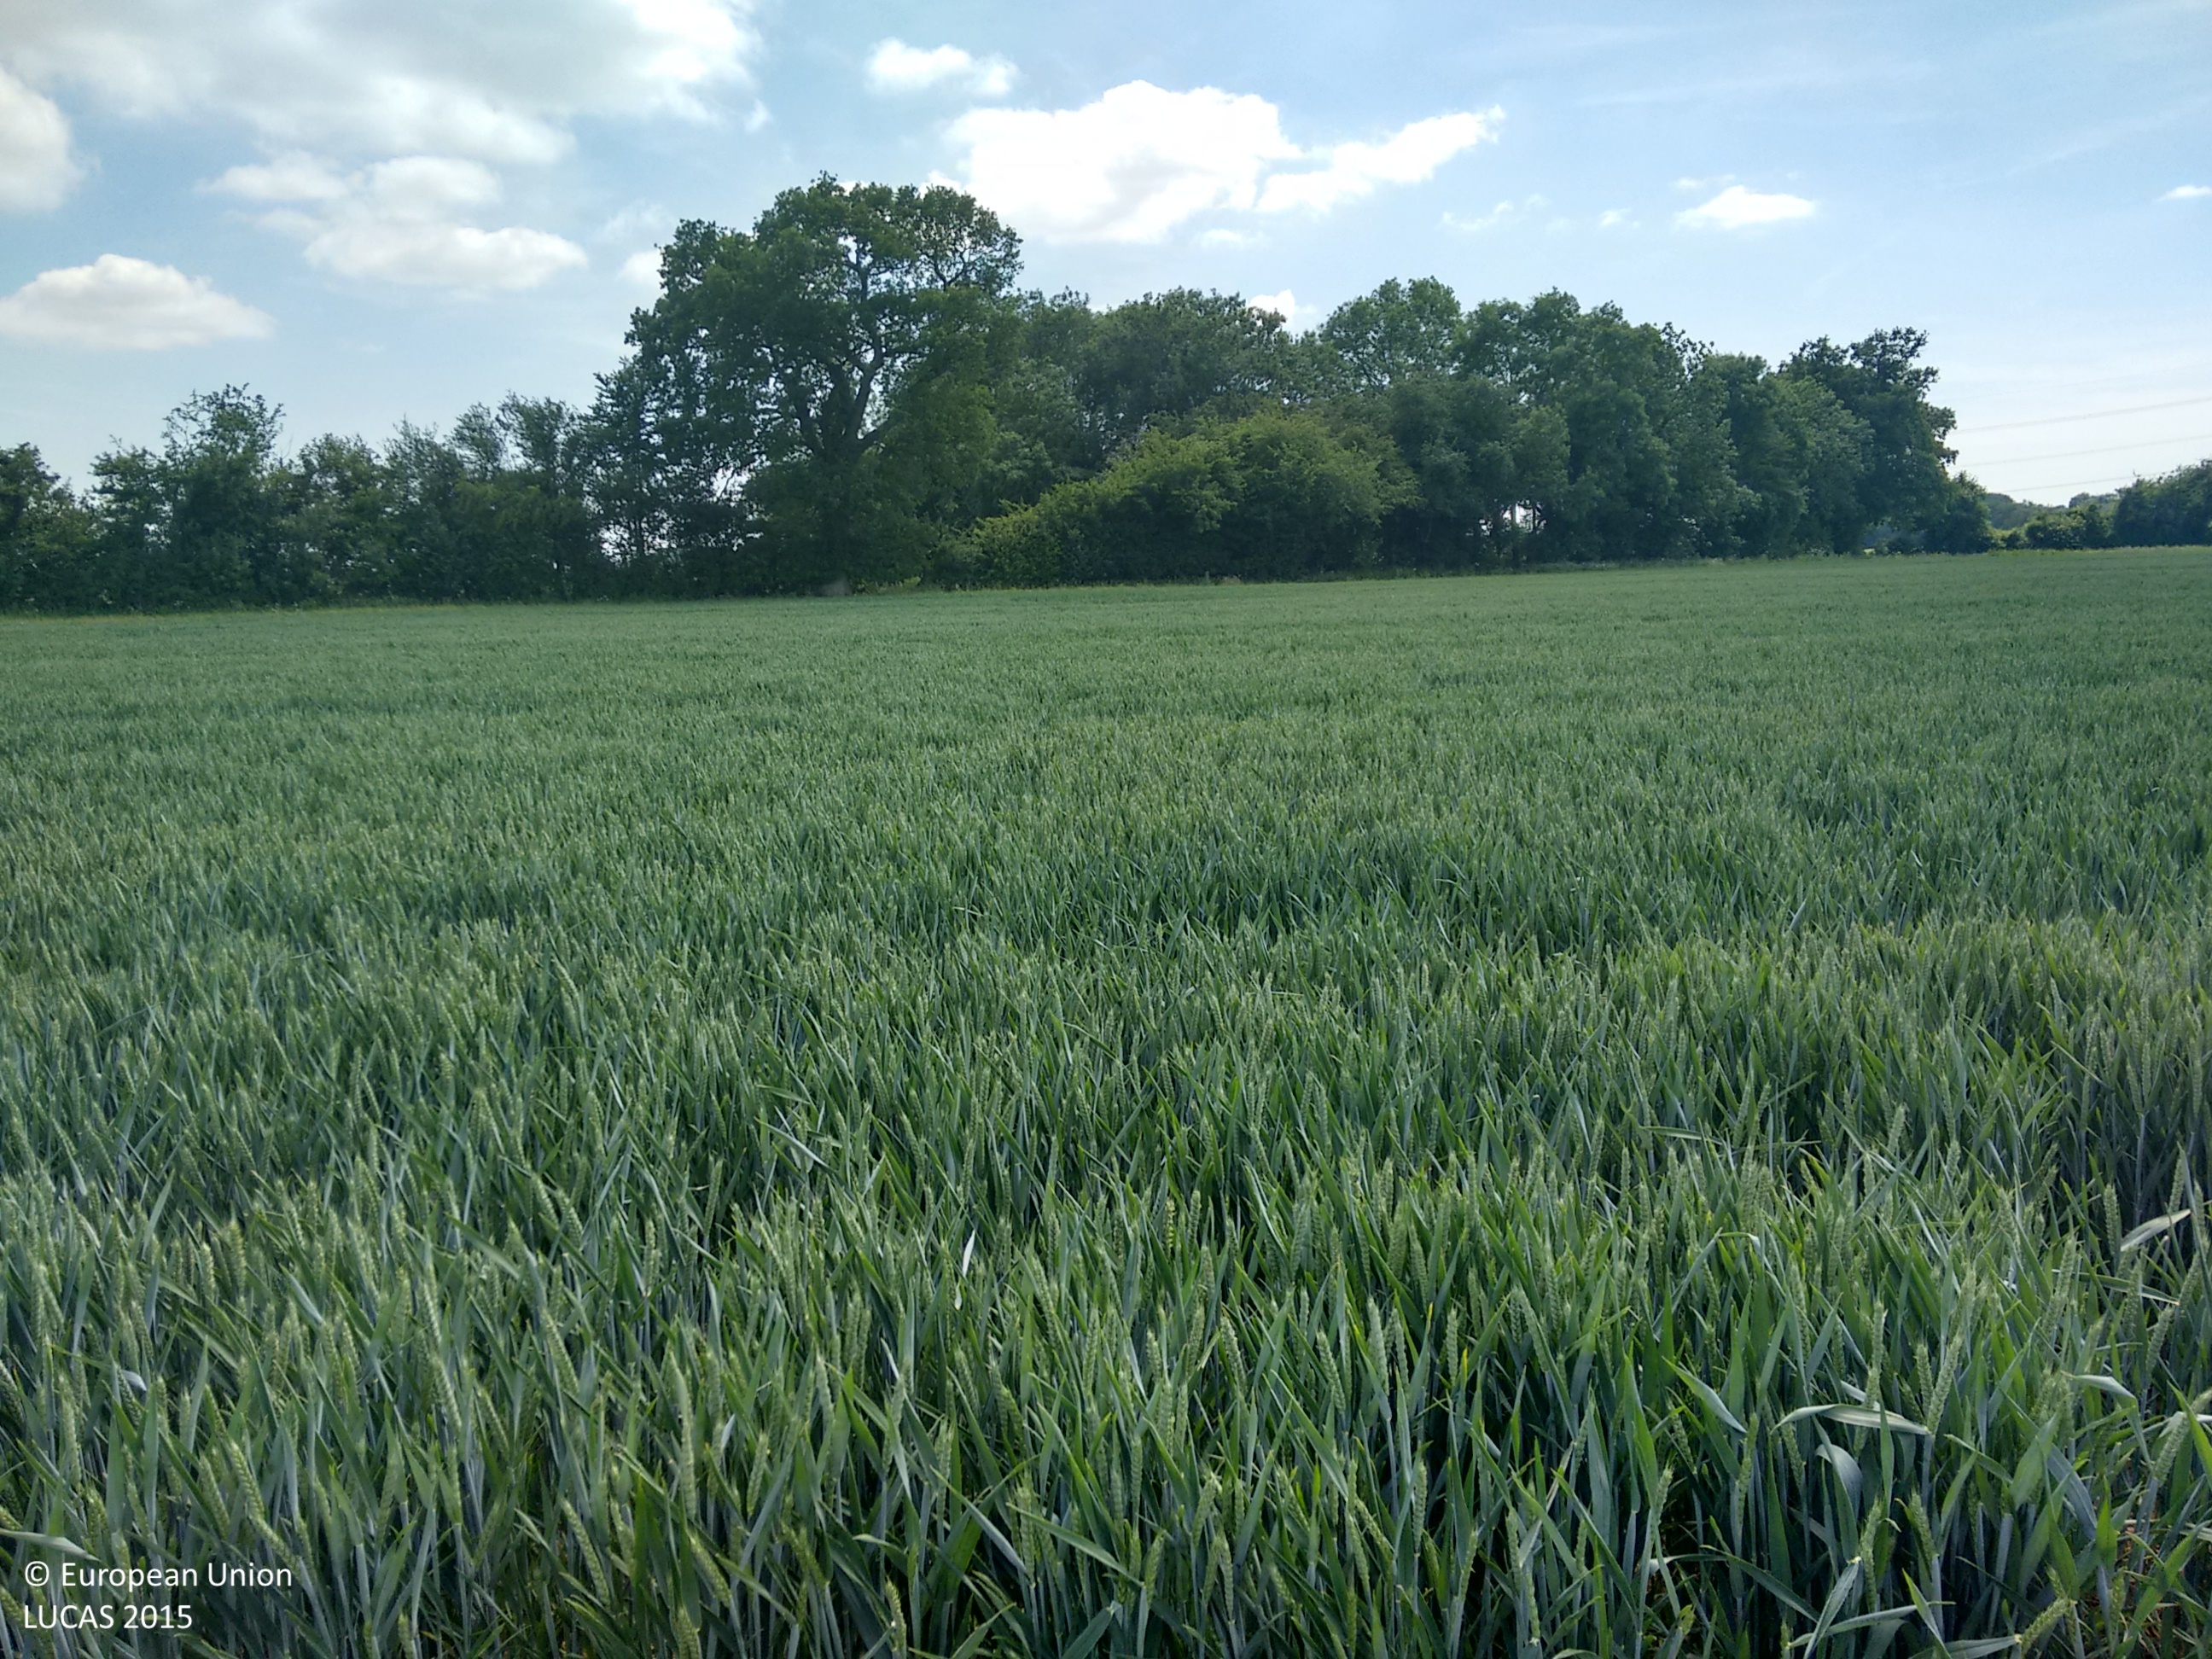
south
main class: Cropland
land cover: Common wheat
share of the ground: > 75 %
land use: Agriculture (excluding fallow land and kitchen gardens)
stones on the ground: < 10 %
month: June
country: GB
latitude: 51.5080
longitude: -2.2077
